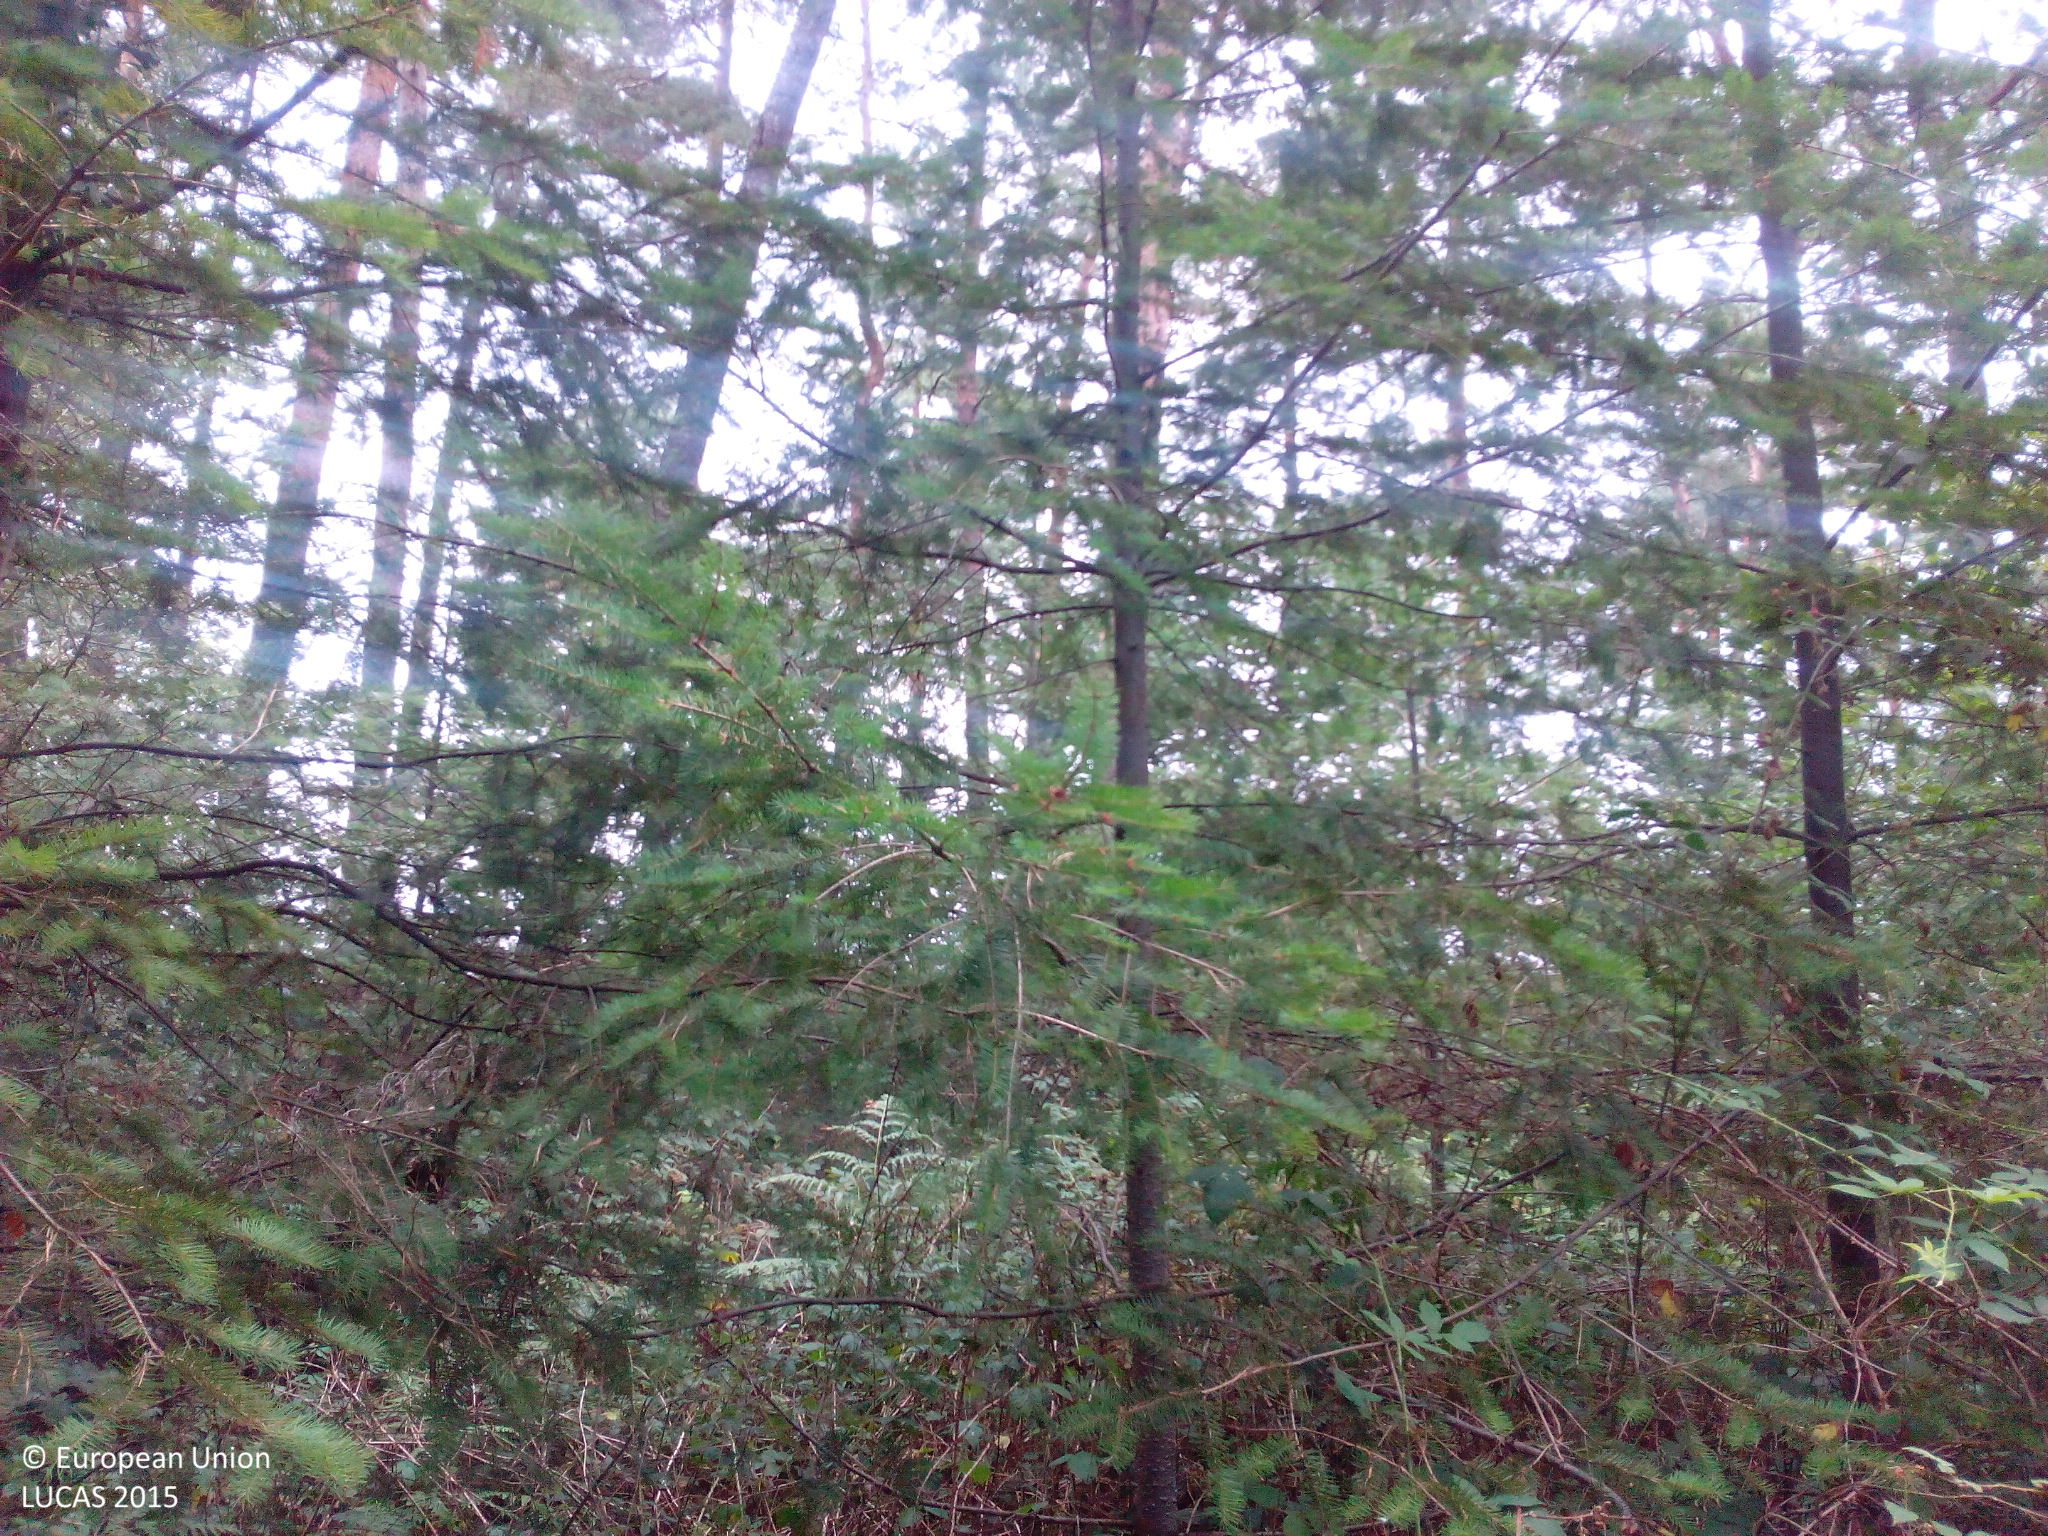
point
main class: Woodland
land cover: Pine dominated coniferous woodland
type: hemiboreal forest and nemoral coniferous forest and mixed broadleaved-coniferous forest
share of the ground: > 75 %
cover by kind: coniferous forest trees 90 %, shrubs 10 %
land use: Forestry
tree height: > 5 m
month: August
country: DE
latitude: 51.7024
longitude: 12.5609
